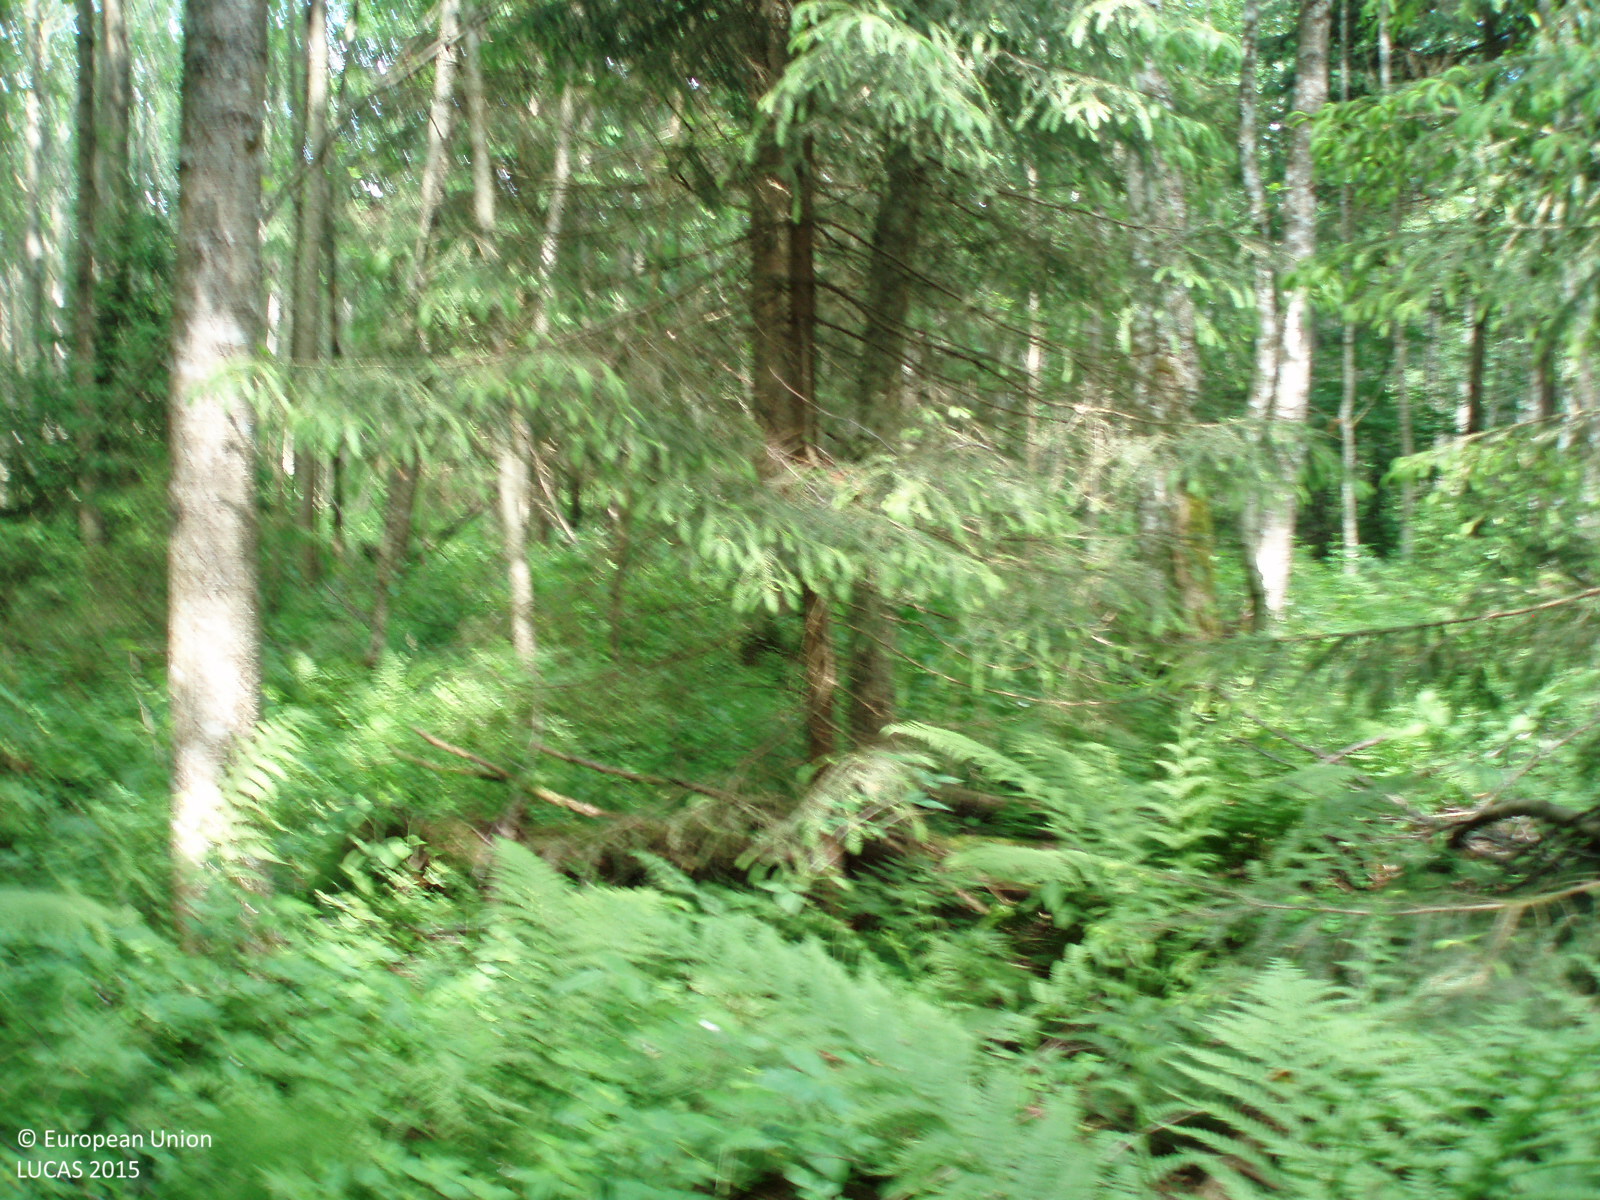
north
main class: Woodland
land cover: Spruce dominated mixed woodland
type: hemiboreal forest and nemoral coniferous forest and mixed broadleaved-coniferous forest
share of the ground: > 75 %
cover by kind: coniferous forest trees 50 %, broadleaved forest trees 40 %, herbaceous plants 10 %
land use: Forestry
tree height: > 5 m
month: June
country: LT
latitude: 55.1923
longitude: 22.4870
